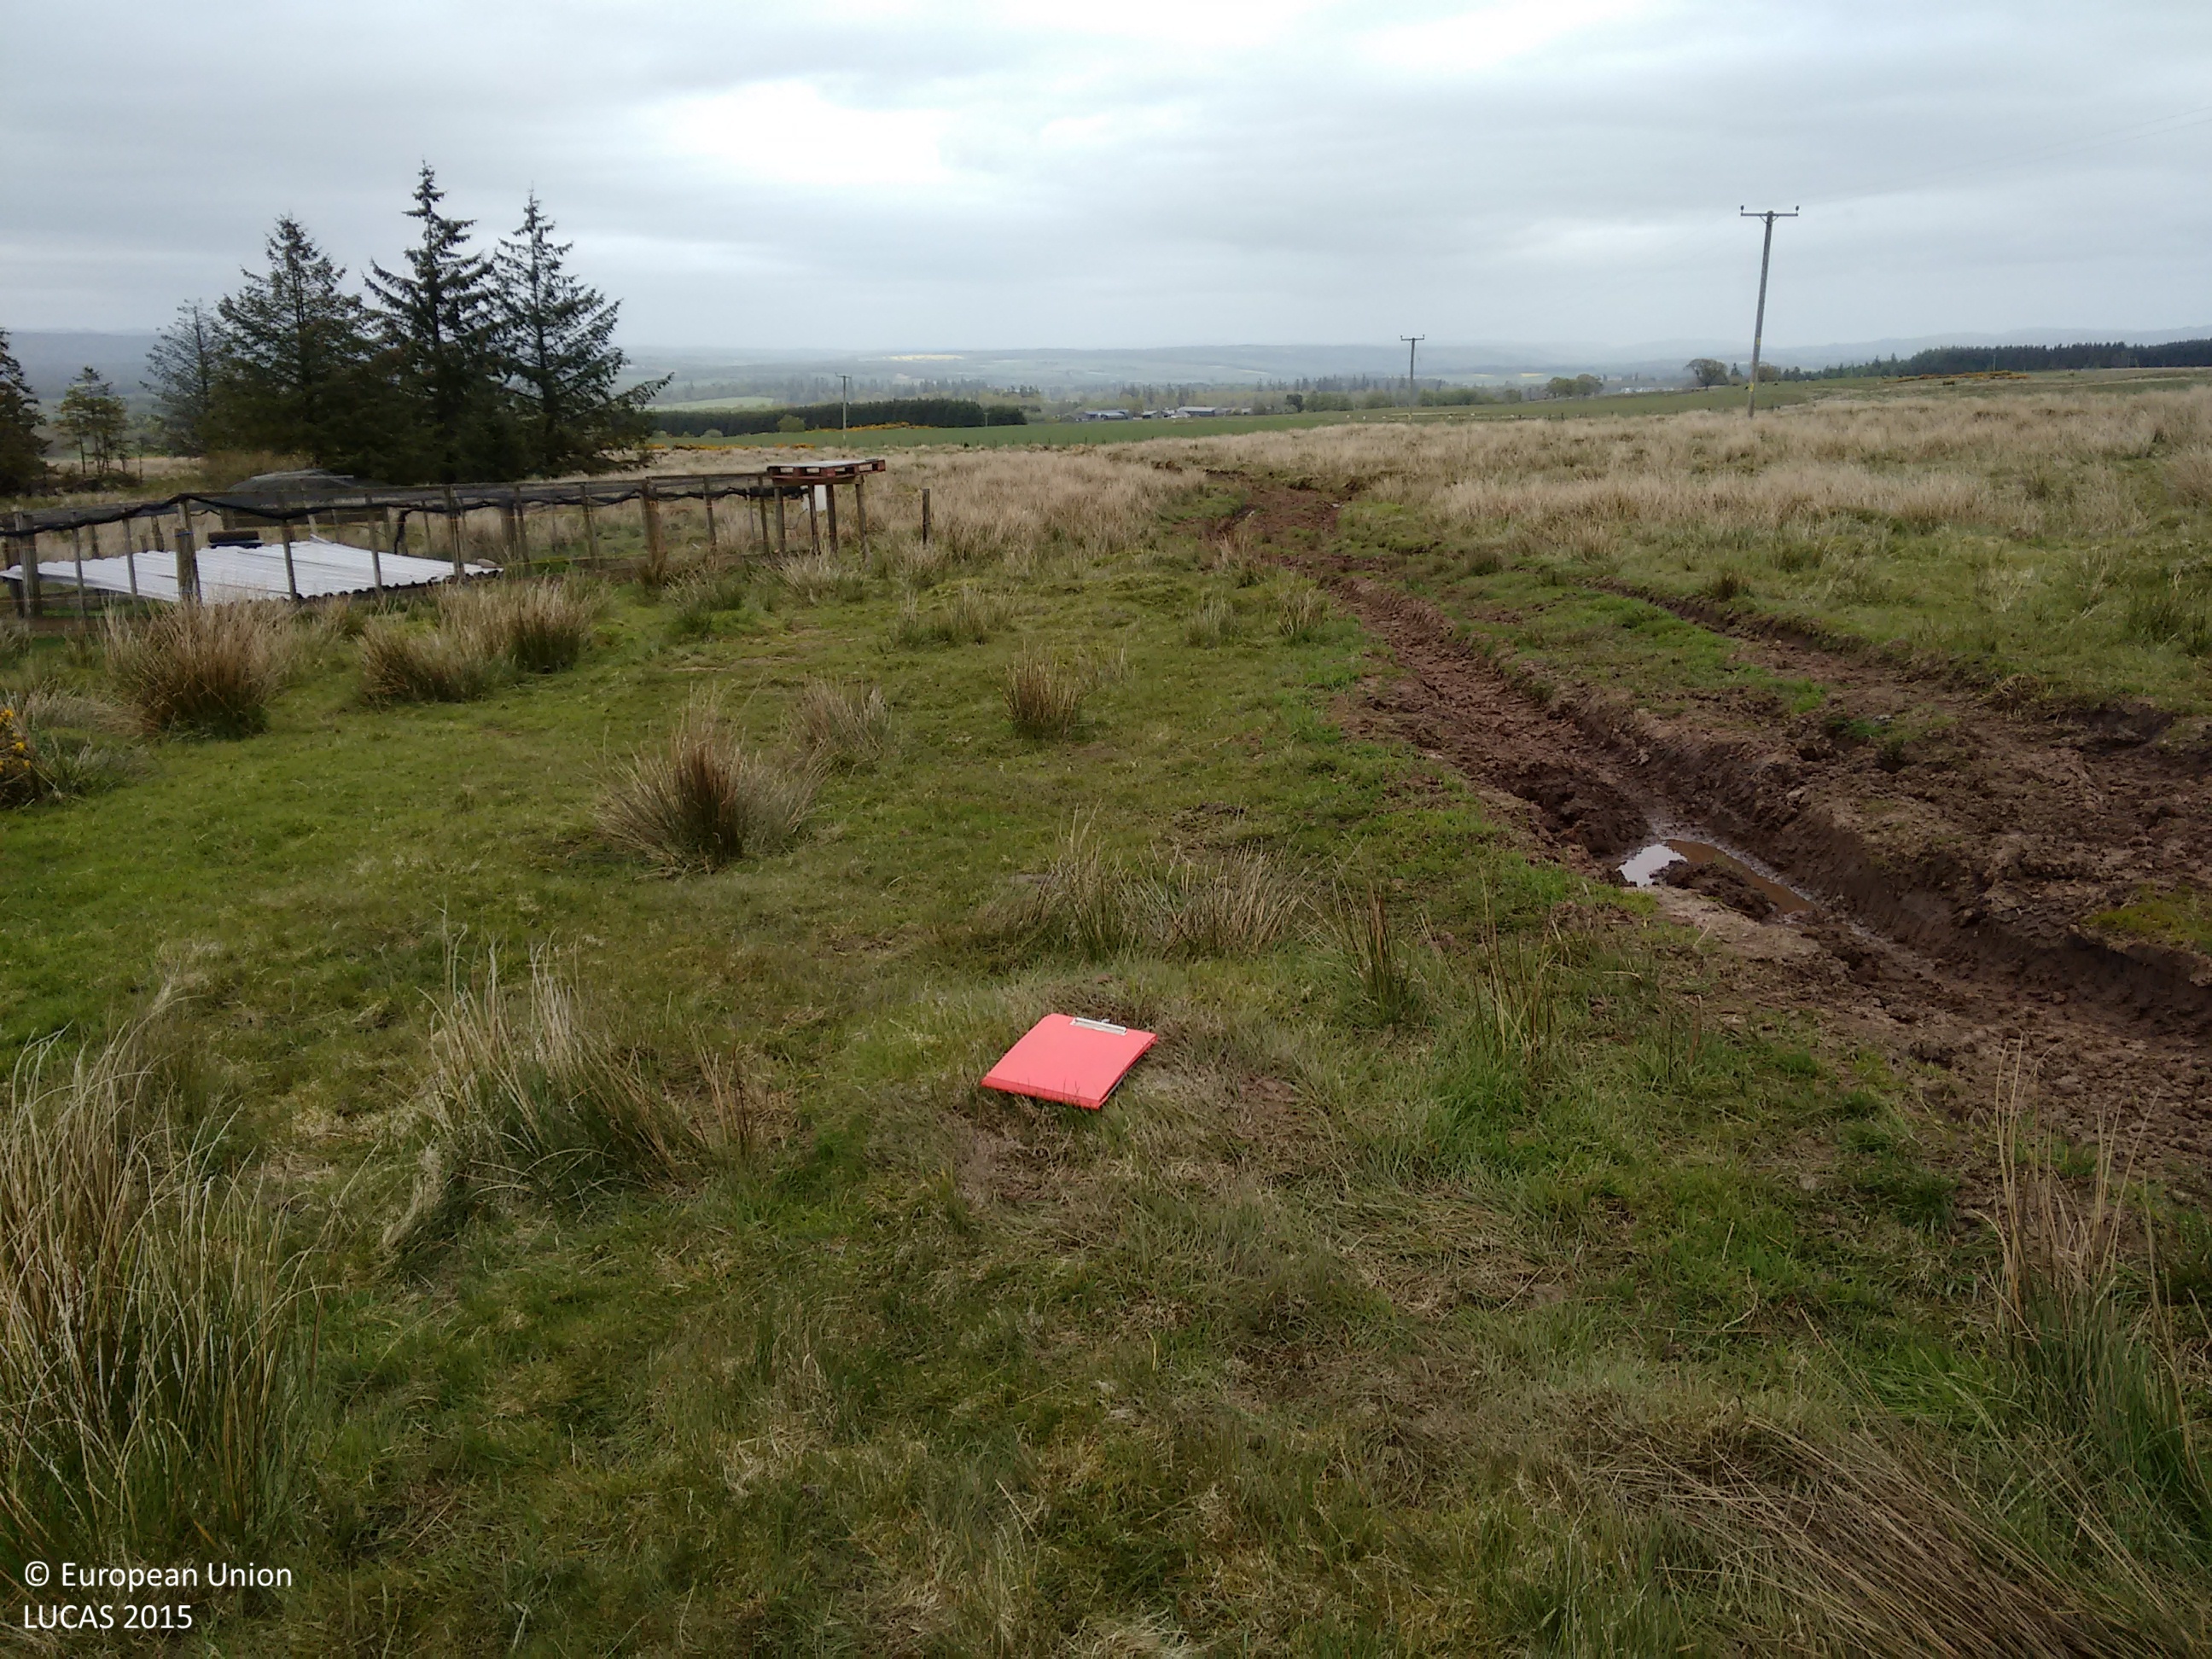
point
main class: Grassland
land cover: Grassland with sparse tree/shrub cover
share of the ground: > 75 %
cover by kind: herbaceous plants 85 %, broadleaved forest trees 5 %, shrubs 5 %, consolidated bare surface 5 %
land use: Agriculture (excluding fallow land and kitchen gardens)
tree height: > 5 m
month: May
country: GB
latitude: 56.2960
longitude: -3.8006
